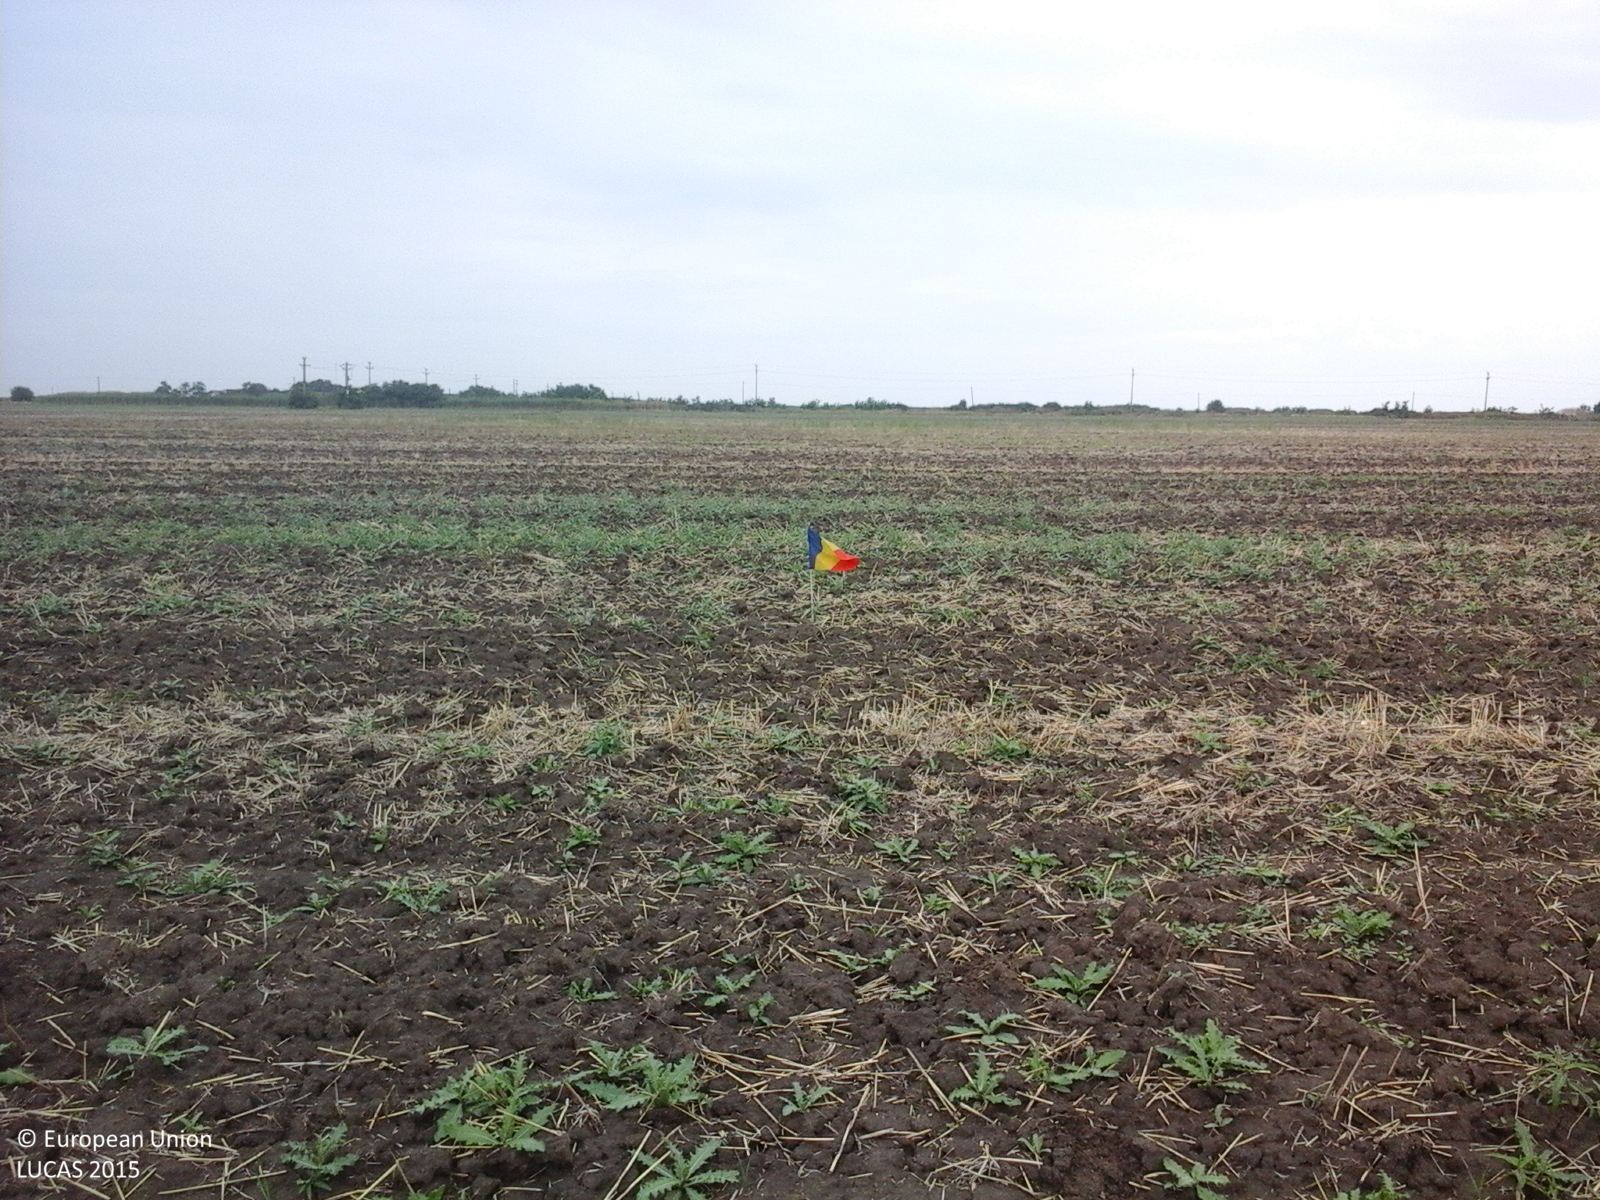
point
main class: Cropland
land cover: Common wheat
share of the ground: < 10 %
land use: Agriculture (excluding fallow land and kitchen gardens)
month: August
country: RO
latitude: 46.0630
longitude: 20.5606
